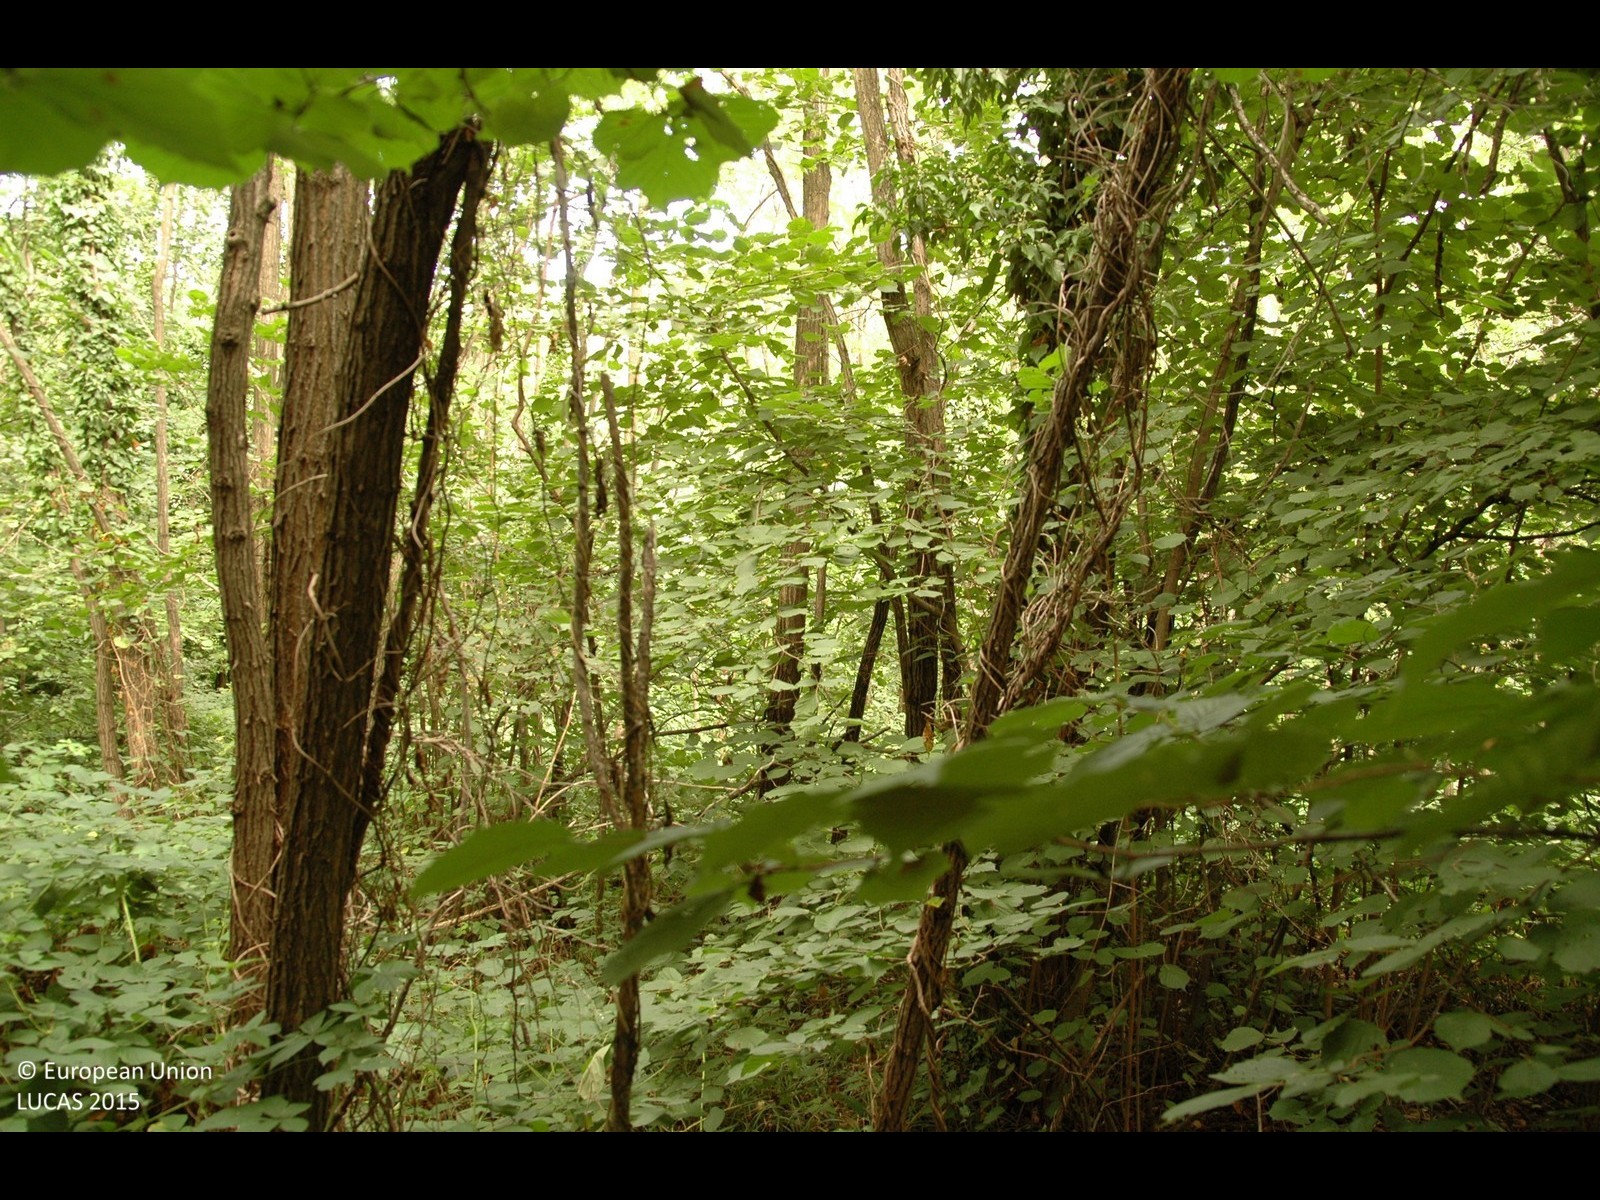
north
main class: Woodland
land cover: Broadleaved woodland
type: mesophytic deciduous forest
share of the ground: > 75 %
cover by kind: broadleaved forest trees 100 %
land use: Forestry
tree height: > 5 m
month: August
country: HR
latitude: 45.9034
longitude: 16.1471
